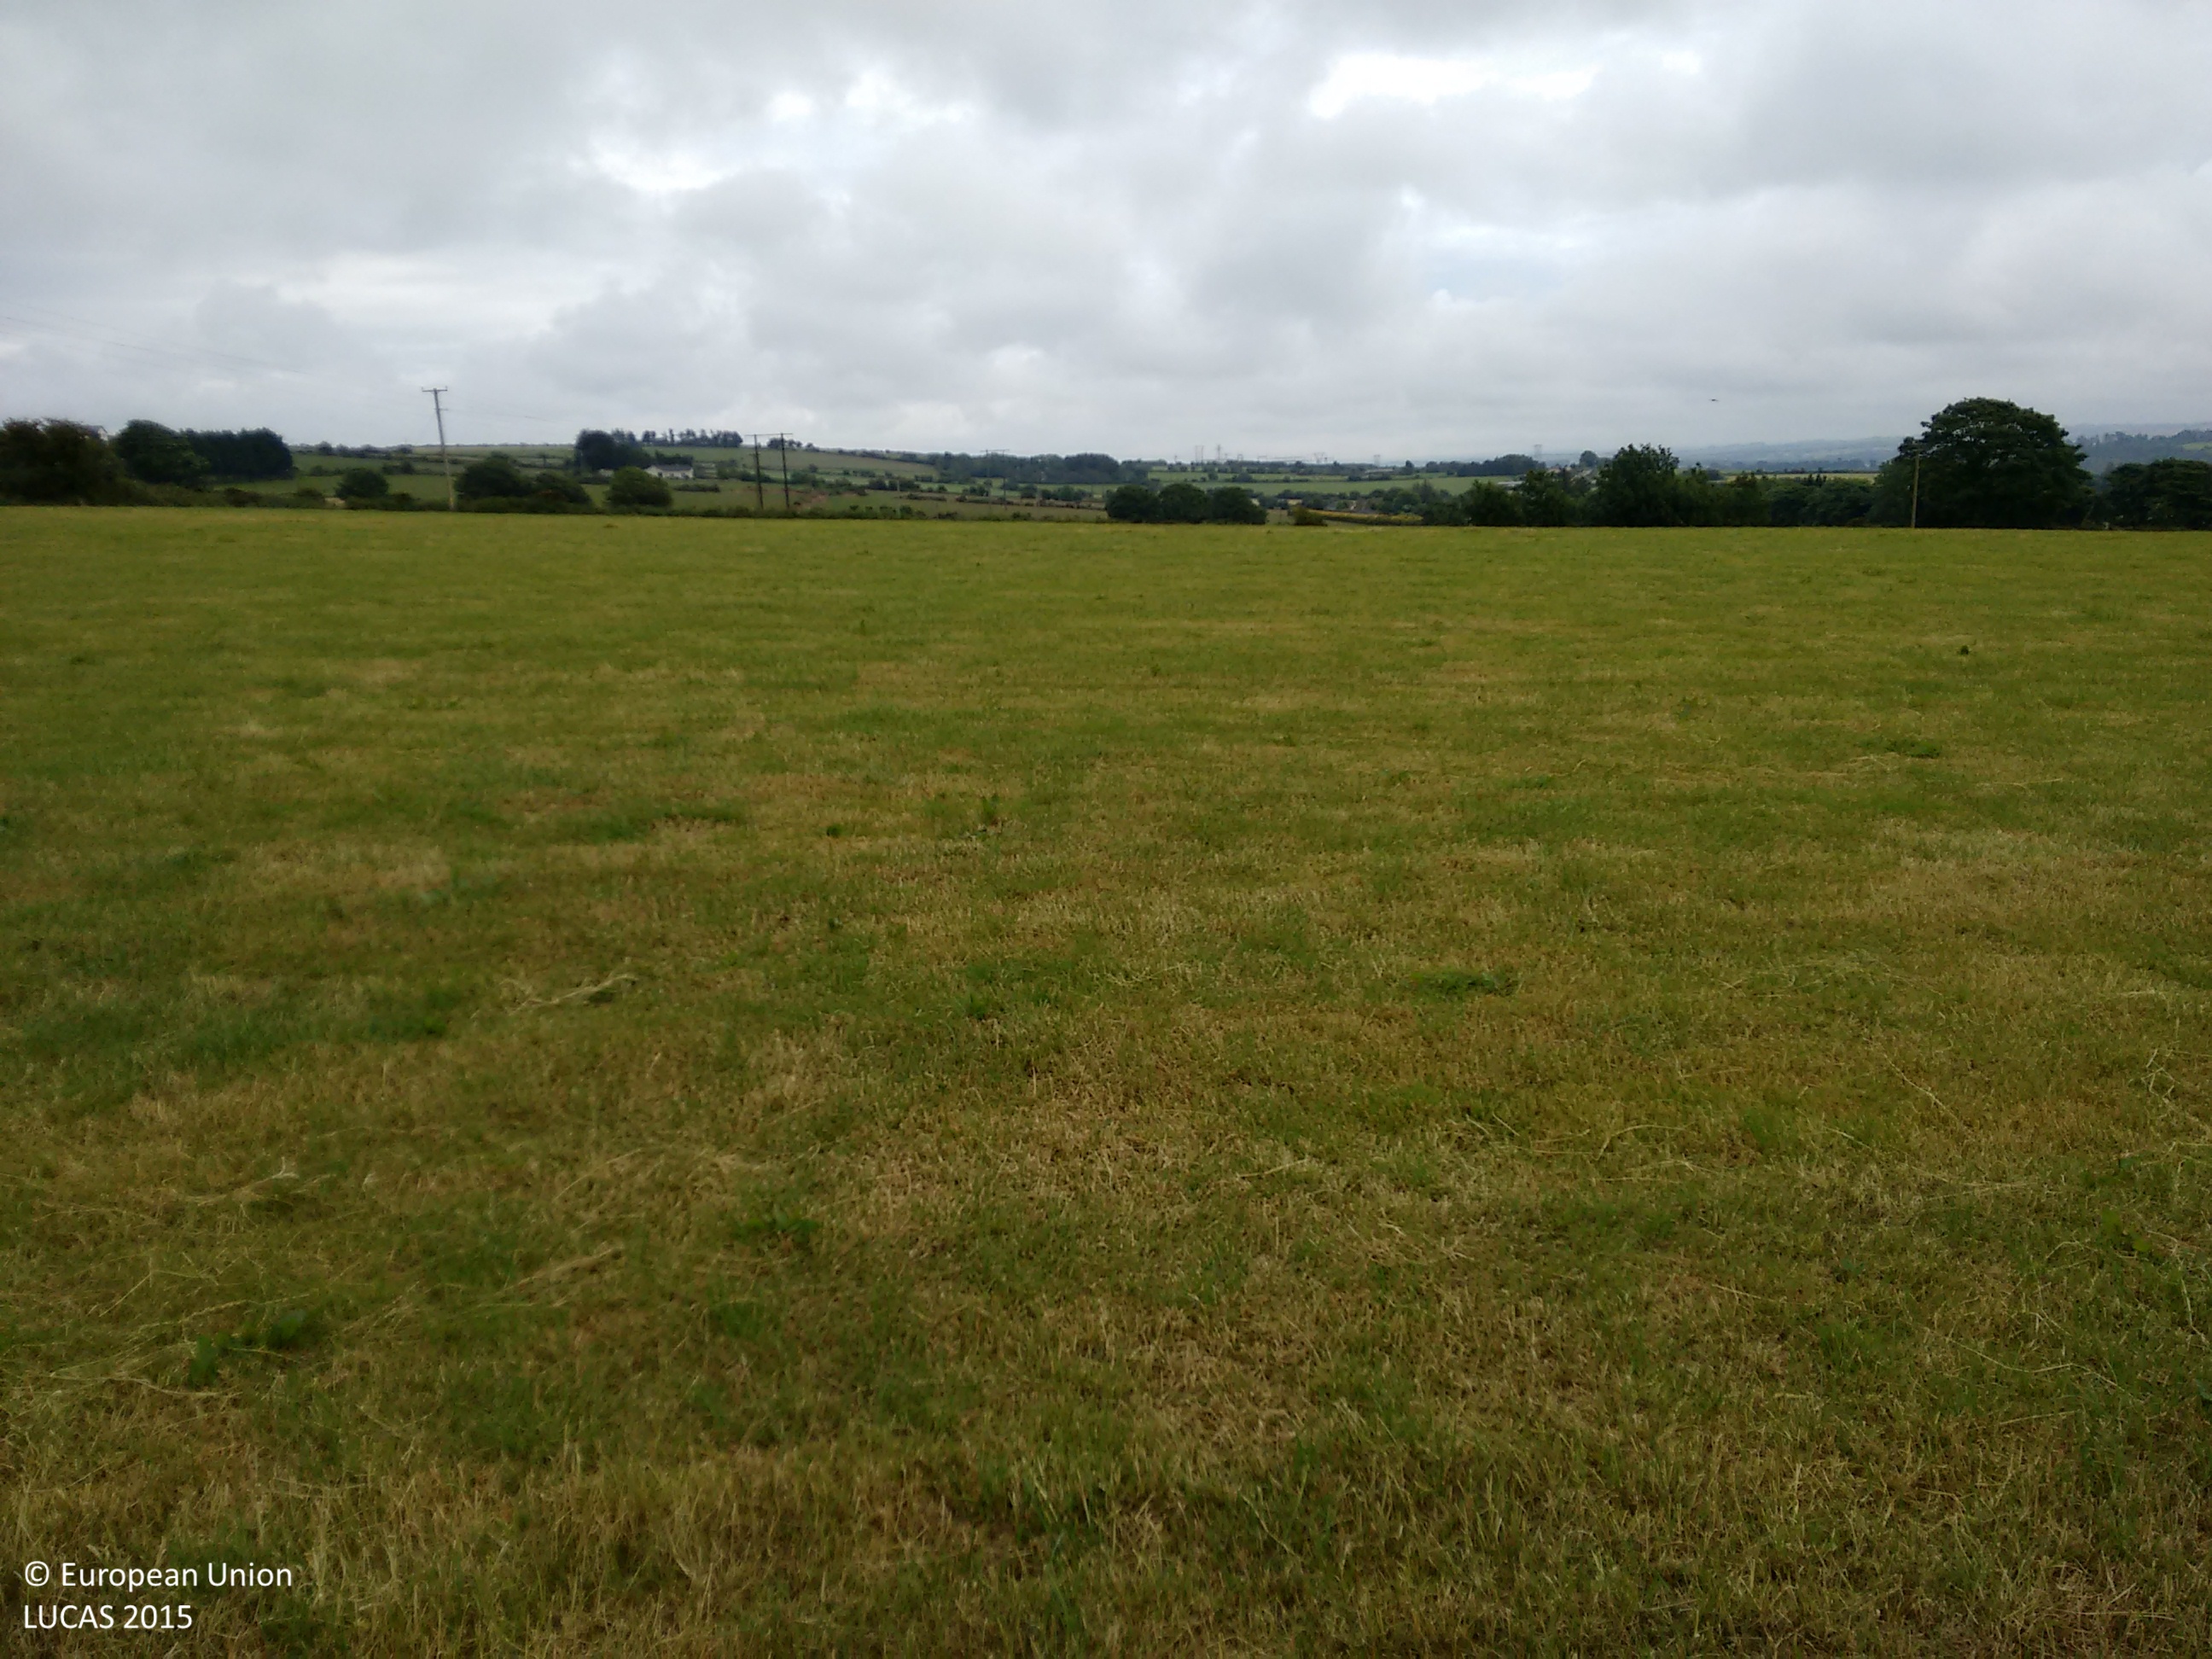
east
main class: Grassland
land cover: Grassland without tree/shrub cover
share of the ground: > 75 %
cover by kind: herbaceous plants 100 %
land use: Agriculture (excluding fallow land and kitchen gardens)
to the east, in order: Grassland without tree/shrub cover; Electric lines; Fences; Abandoned hedges; Fences; Grassland without tree/shrub cover
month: June
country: IE
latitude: 52.2521
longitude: -7.3060
